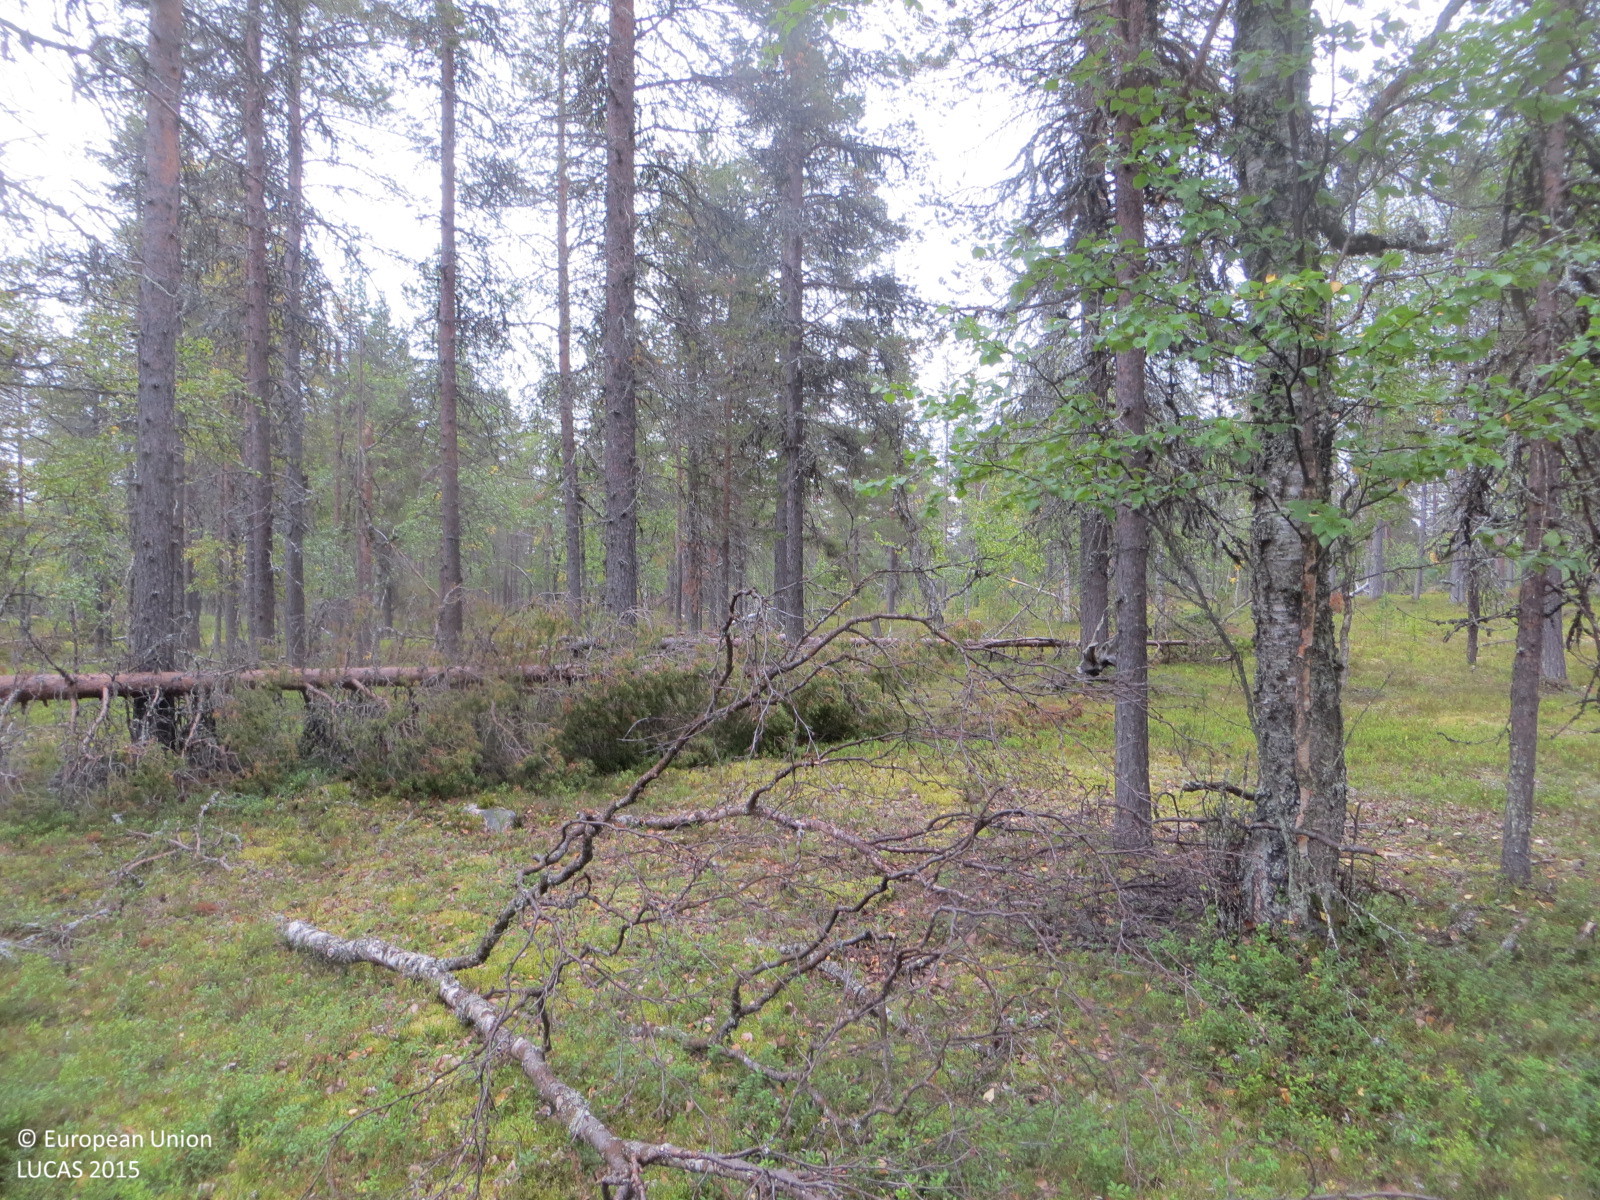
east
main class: Woodland
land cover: Pine dominated coniferous woodland
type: boreal forest
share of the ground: 50 - 75 %
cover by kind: coniferous forest trees 50 %, shrubs 50 %
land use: Forestry
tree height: > 5 m
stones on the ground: 25 - 50 %
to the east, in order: Pine dominated coniferous woodland; Pine dominated mixed woodland
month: August
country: FI
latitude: 68.1420
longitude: 25.6135
